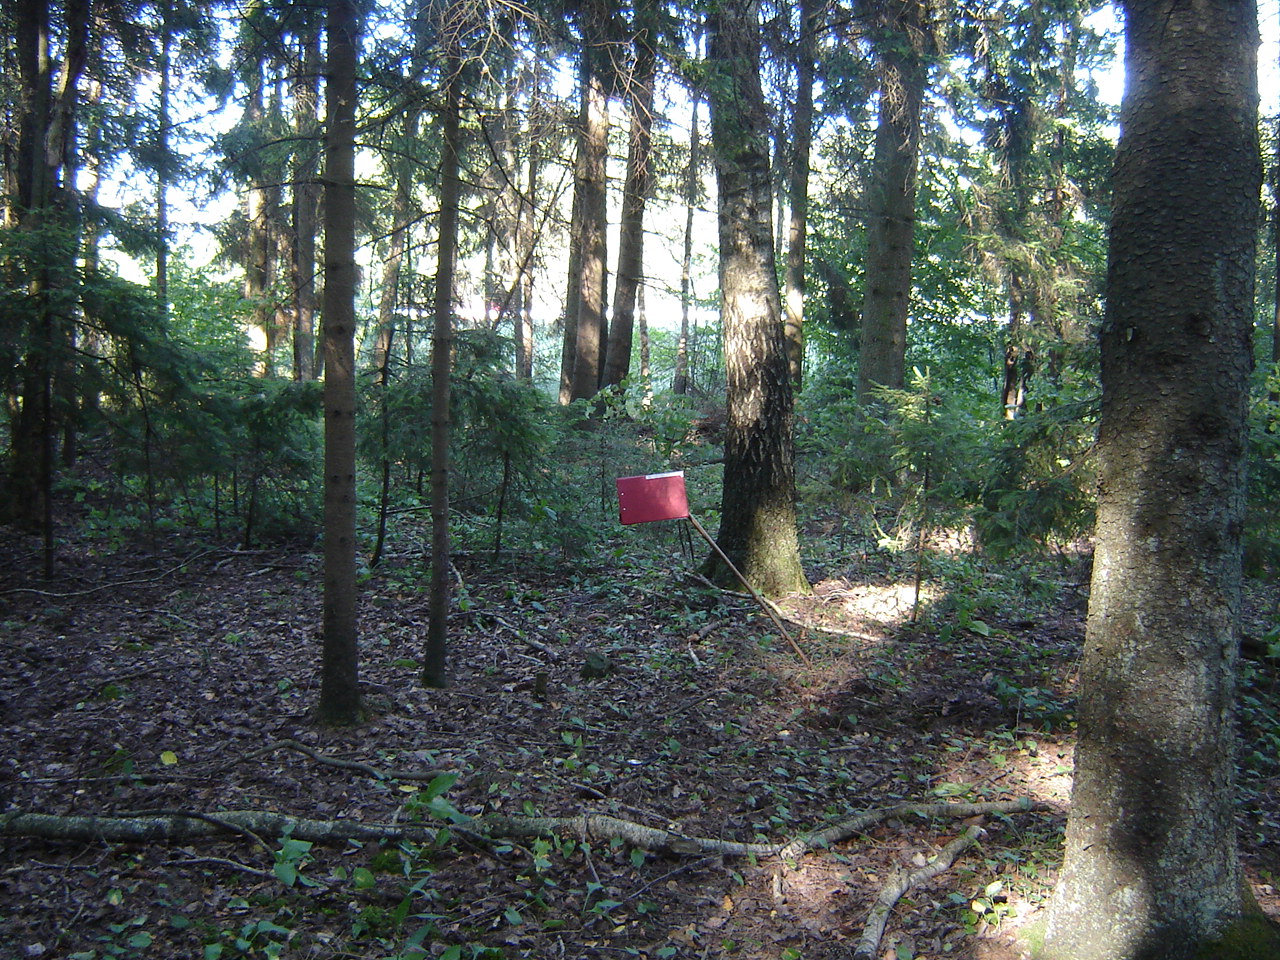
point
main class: Woodland
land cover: Spruce dominated mixed woodland
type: hemiboreal forest and nemoral coniferous forest and mixed broadleaved-coniferous forest
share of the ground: > 75 %
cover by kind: coniferous forest trees 60 %, broadleaved forest trees 30 %, herbaceous plants 5 %, unconsolidated bare surface 5 %
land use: Forestry
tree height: > 5 m
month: August
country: LT
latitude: 55.0363
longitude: 24.8974
